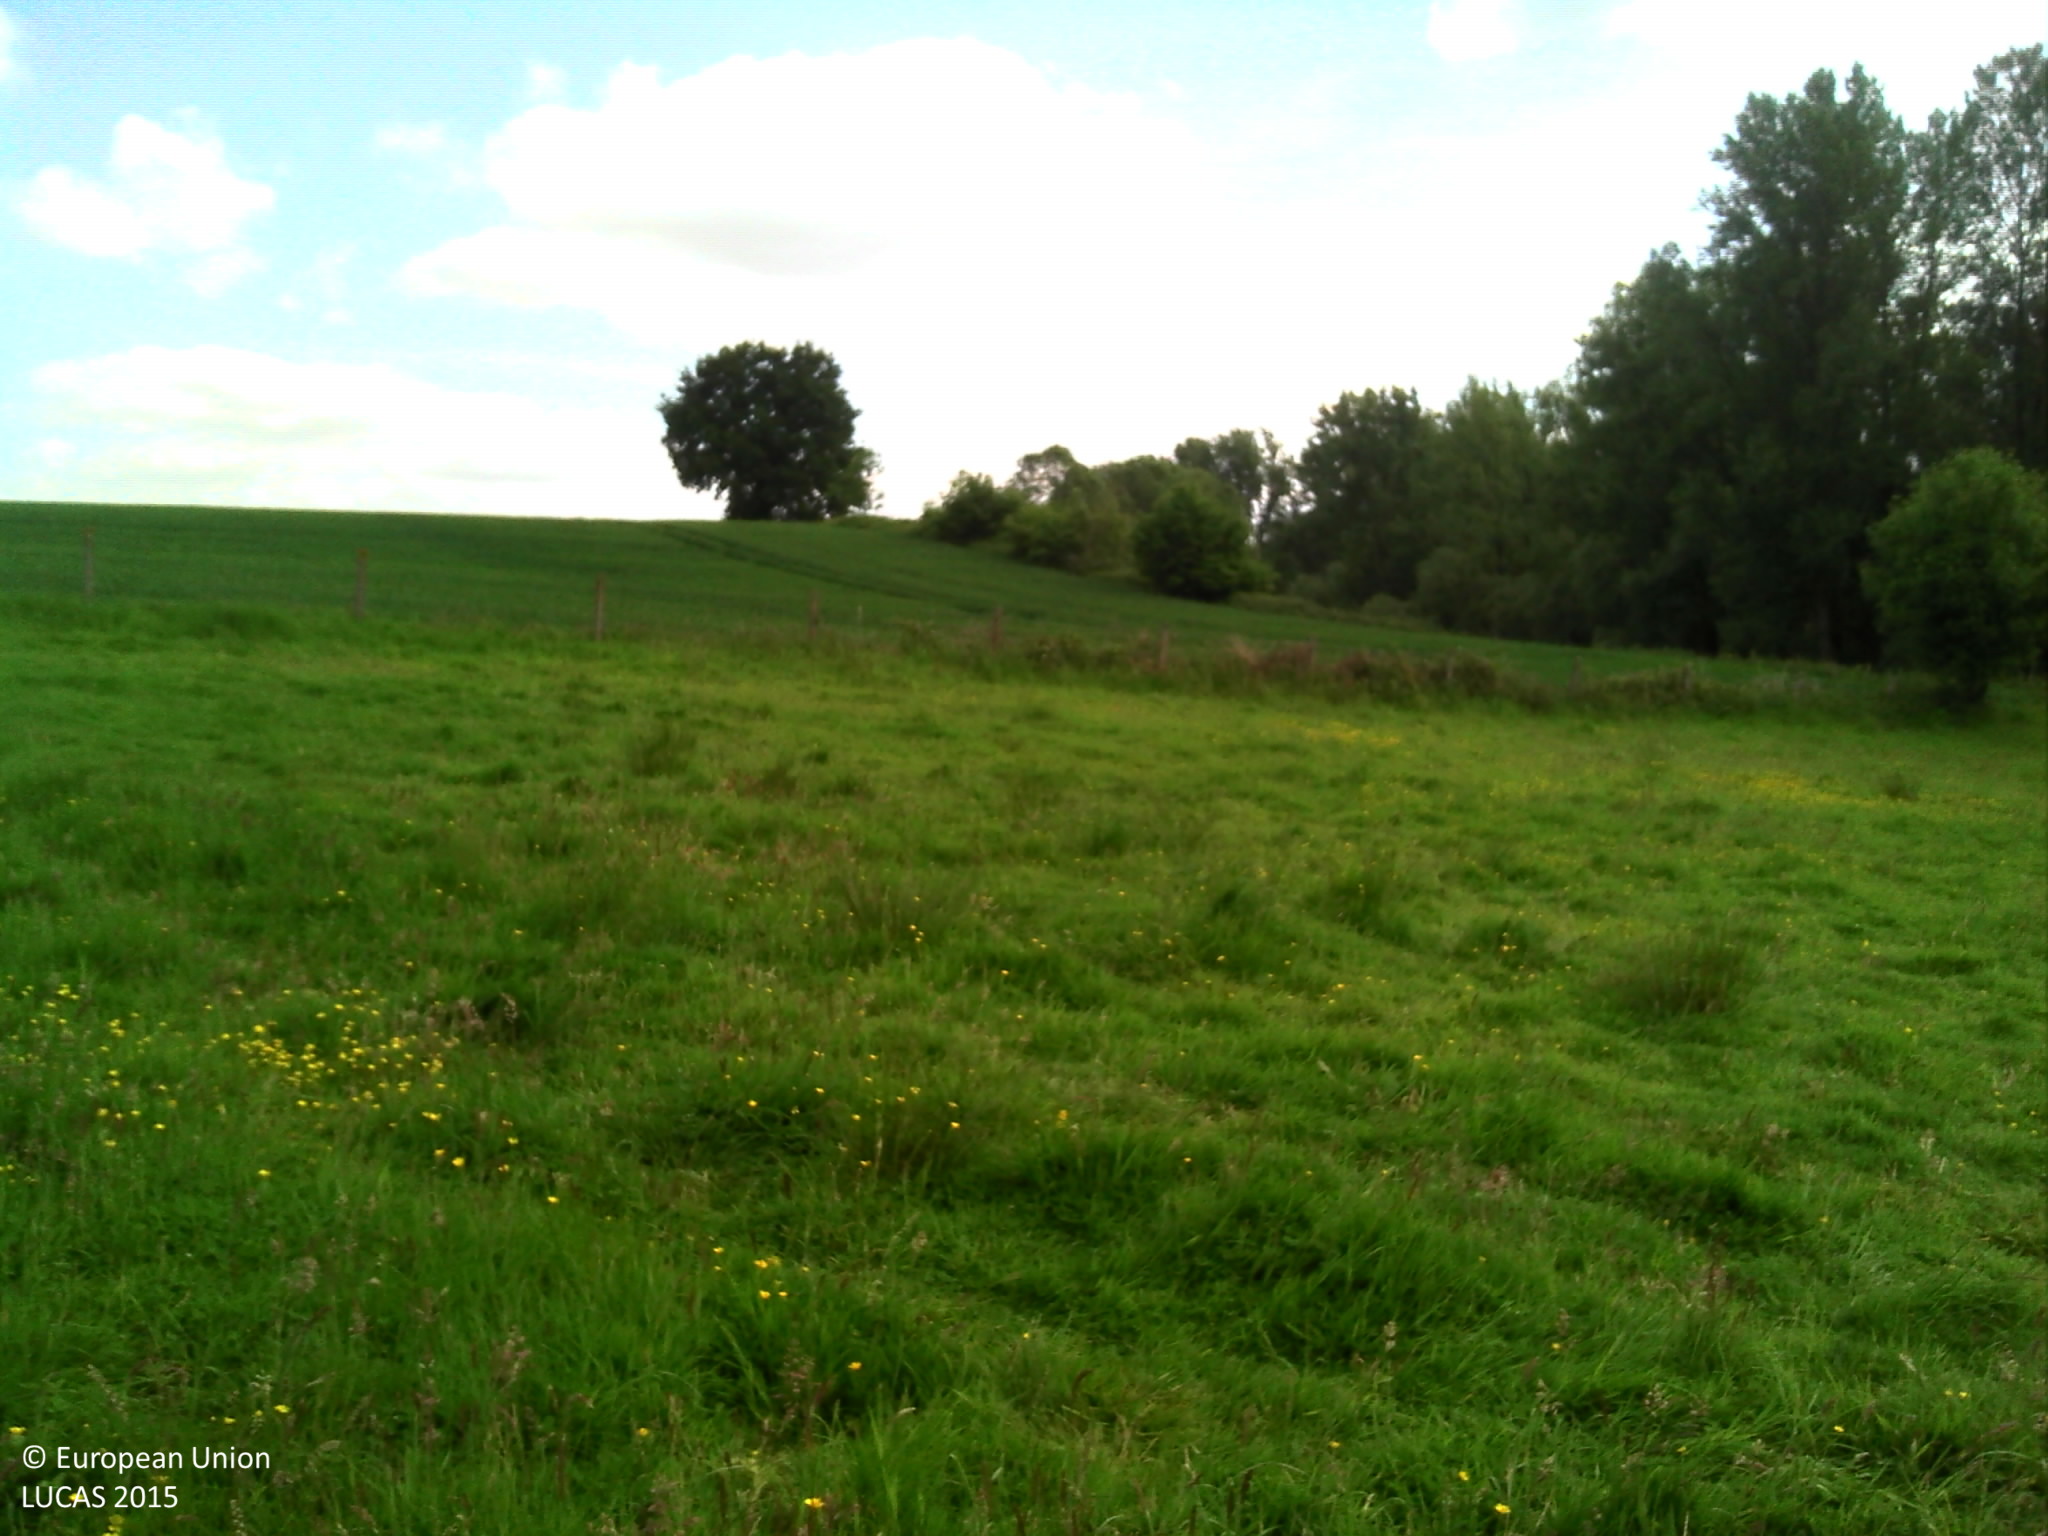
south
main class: Grassland
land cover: Grassland without tree/shrub cover
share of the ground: > 75 %
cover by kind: herbaceous plants 100 %
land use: Agriculture (excluding fallow land and kitchen gardens)
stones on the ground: < 10 %
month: June
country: BE
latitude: 50.7833
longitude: 3.9945
